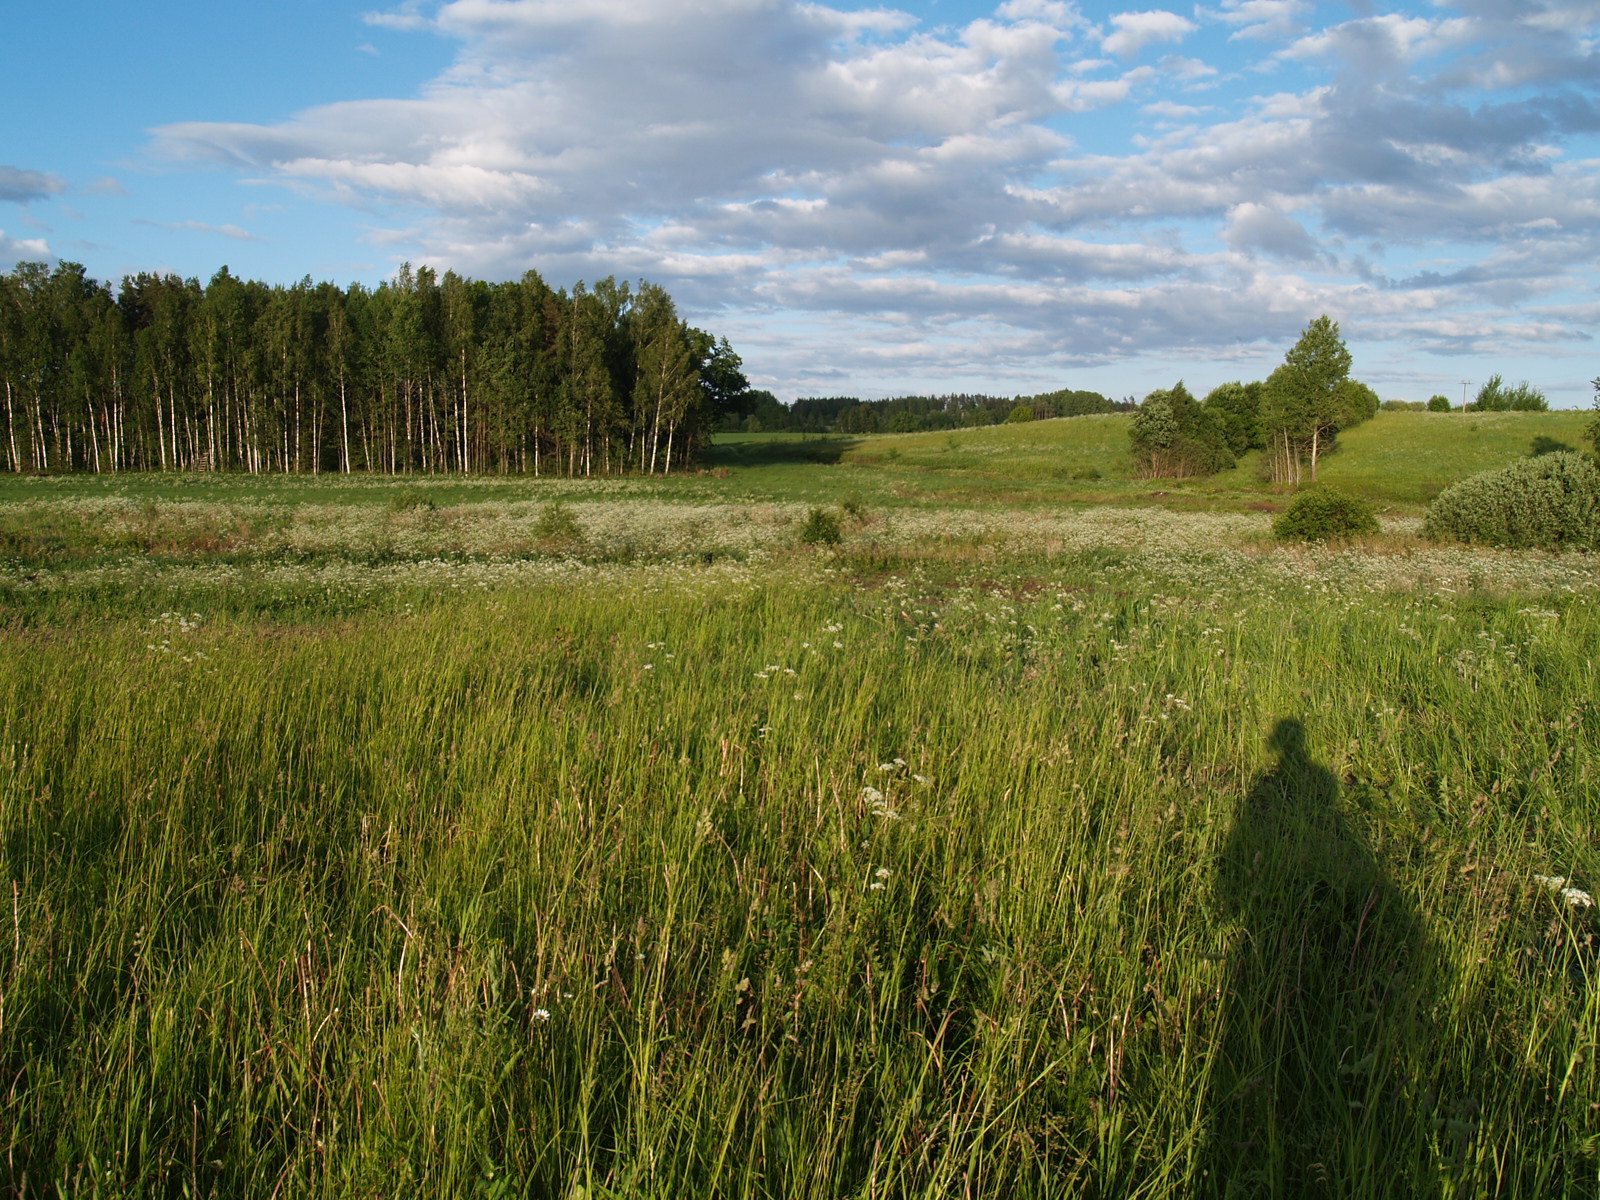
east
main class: Grassland
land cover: Grassland without tree/shrub cover
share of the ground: > 75 %
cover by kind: herbaceous plants 100 %
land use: Agriculture (excluding fallow land and kitchen gardens)
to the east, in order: Grassland without tree/shrub cover; Ditches and canals; Spontaneously vegetated surfaces; Barley; Broadleaved woodland; Barley
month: June
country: LV
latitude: 56.6488
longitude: 25.6666
